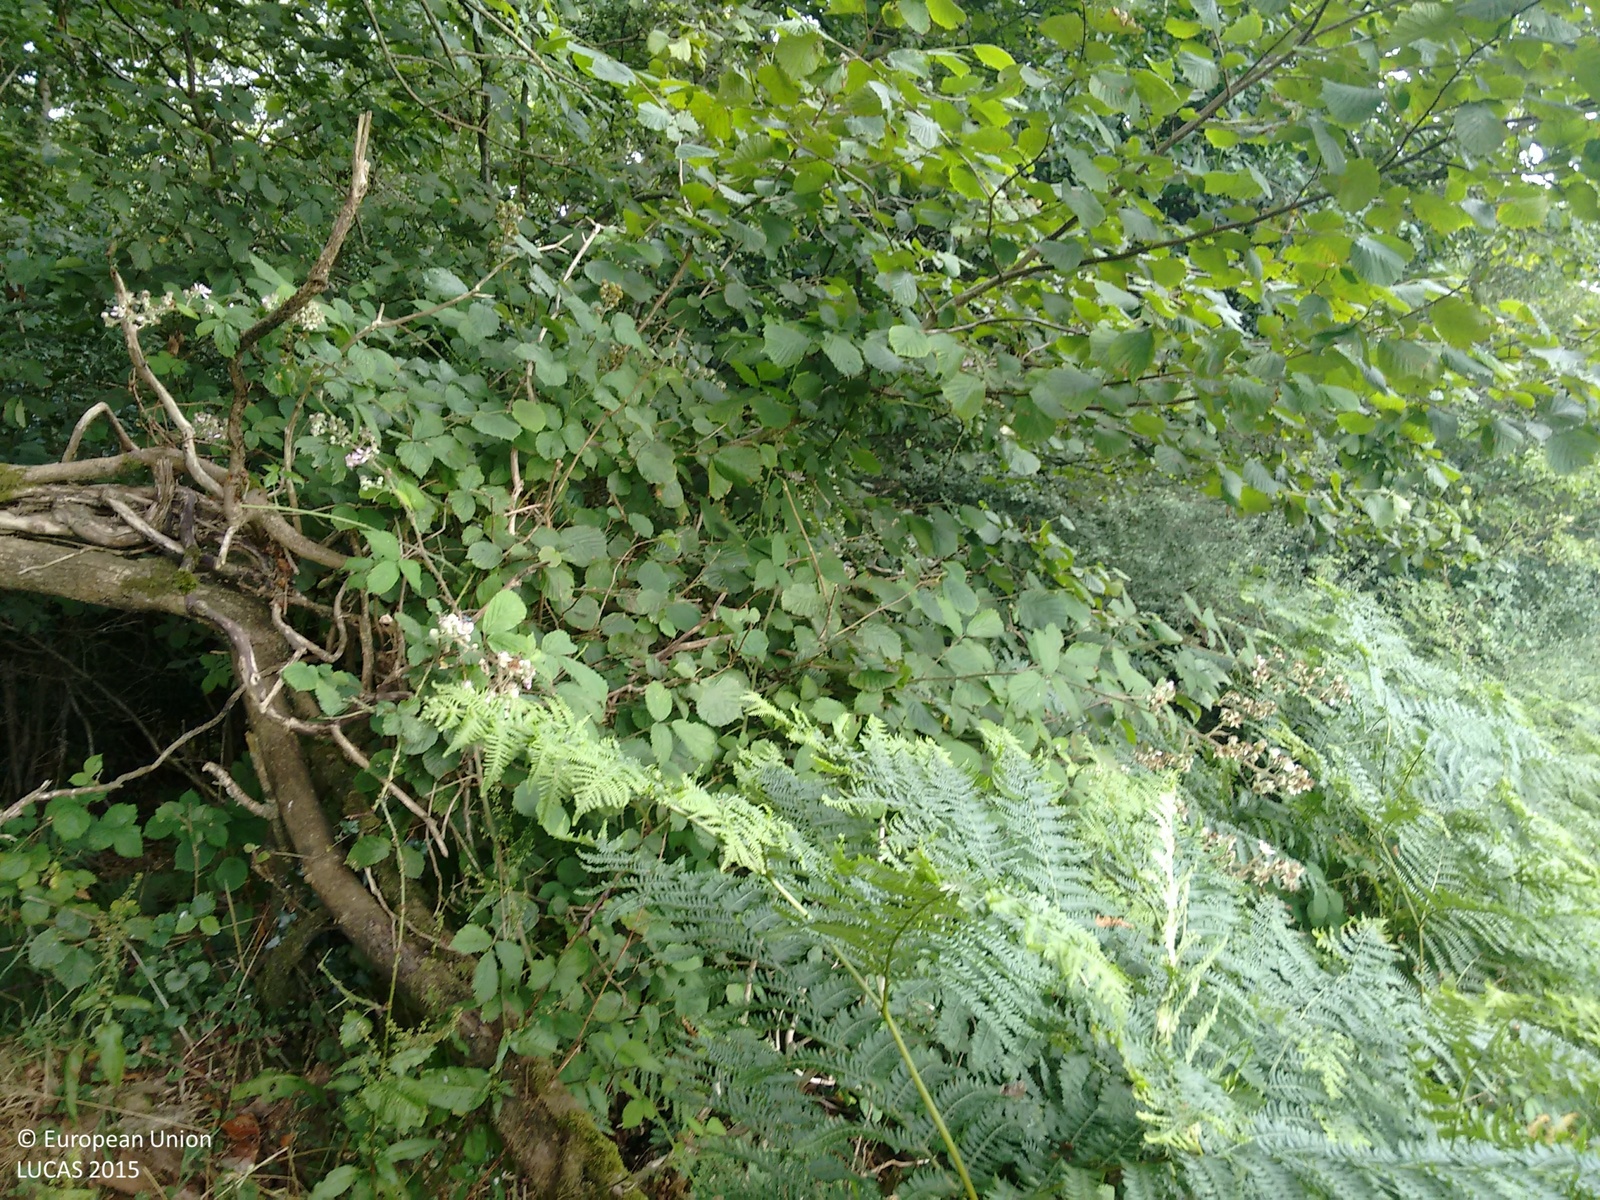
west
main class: Woodland
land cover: Broadleaved woodland
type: mesophytic deciduous forest
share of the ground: > 75 %
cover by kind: broadleaved forest trees 100 %
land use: Semi-natural and natural areas not in use
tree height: > 5 m
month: August
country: GB
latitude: 50.8739
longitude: -3.4849
